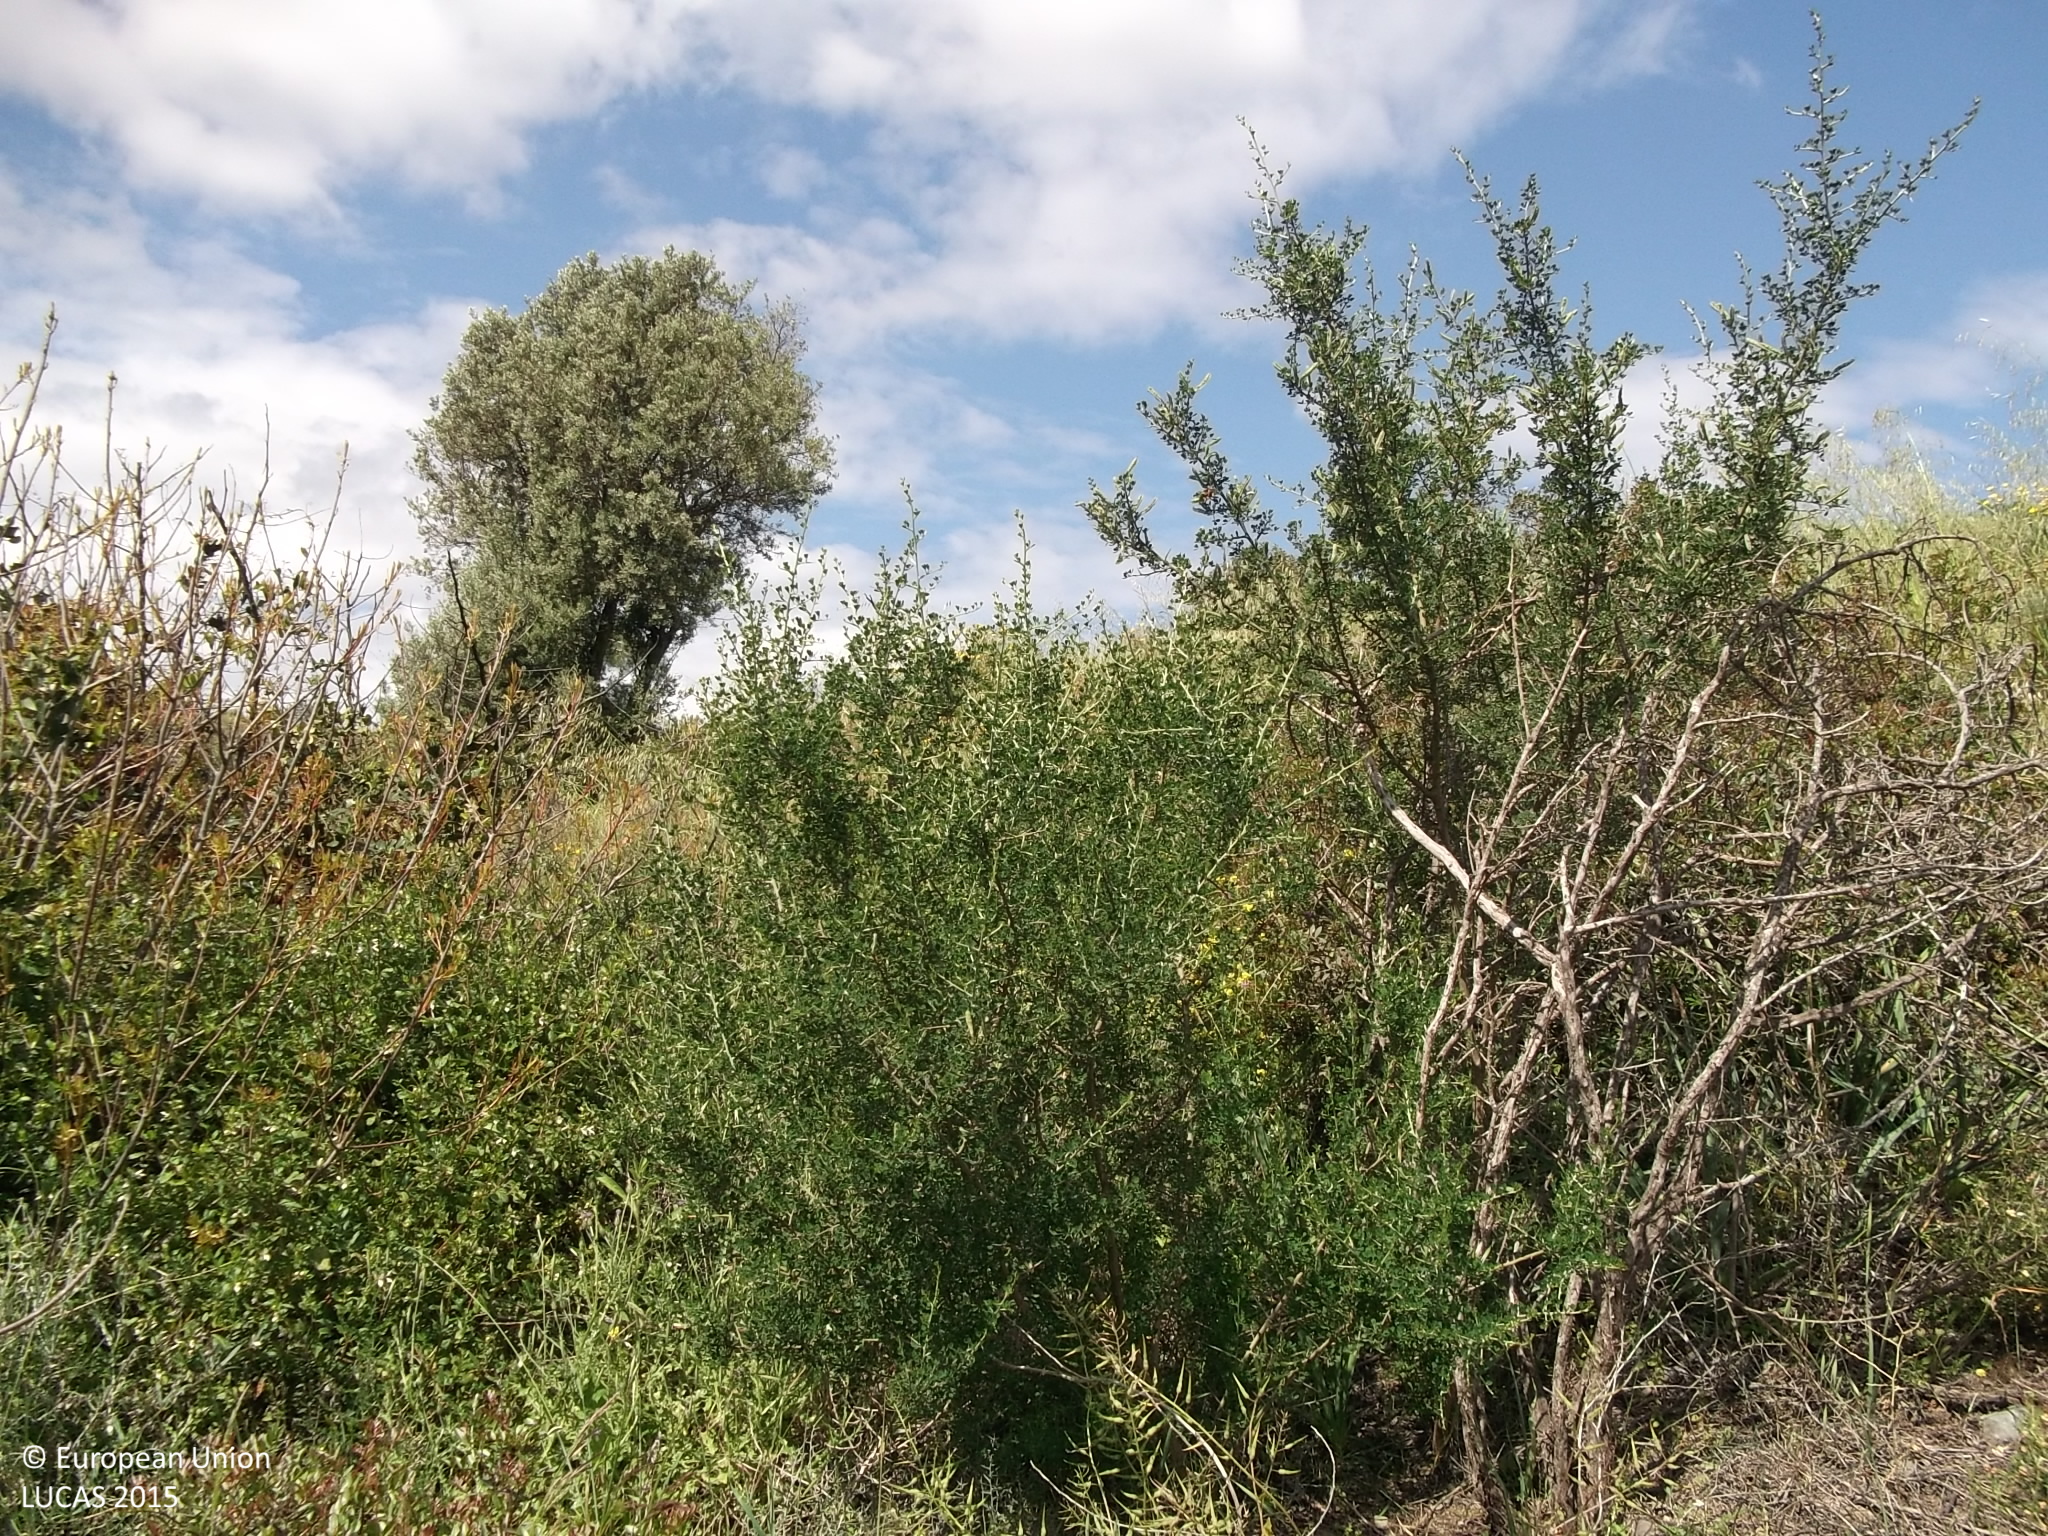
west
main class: Shrubland
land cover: Shrubland with sparse tree cover
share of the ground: 50 - 75 %
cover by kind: shrubs 50 %, herbaceous plants 25 %, consolidated bare surface 10 %, unconsolidated bare surface 10 %, coniferous forest trees 5 %
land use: Semi-natural and natural areas not in use
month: April
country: CY
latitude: 34.8525
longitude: 33.4274
